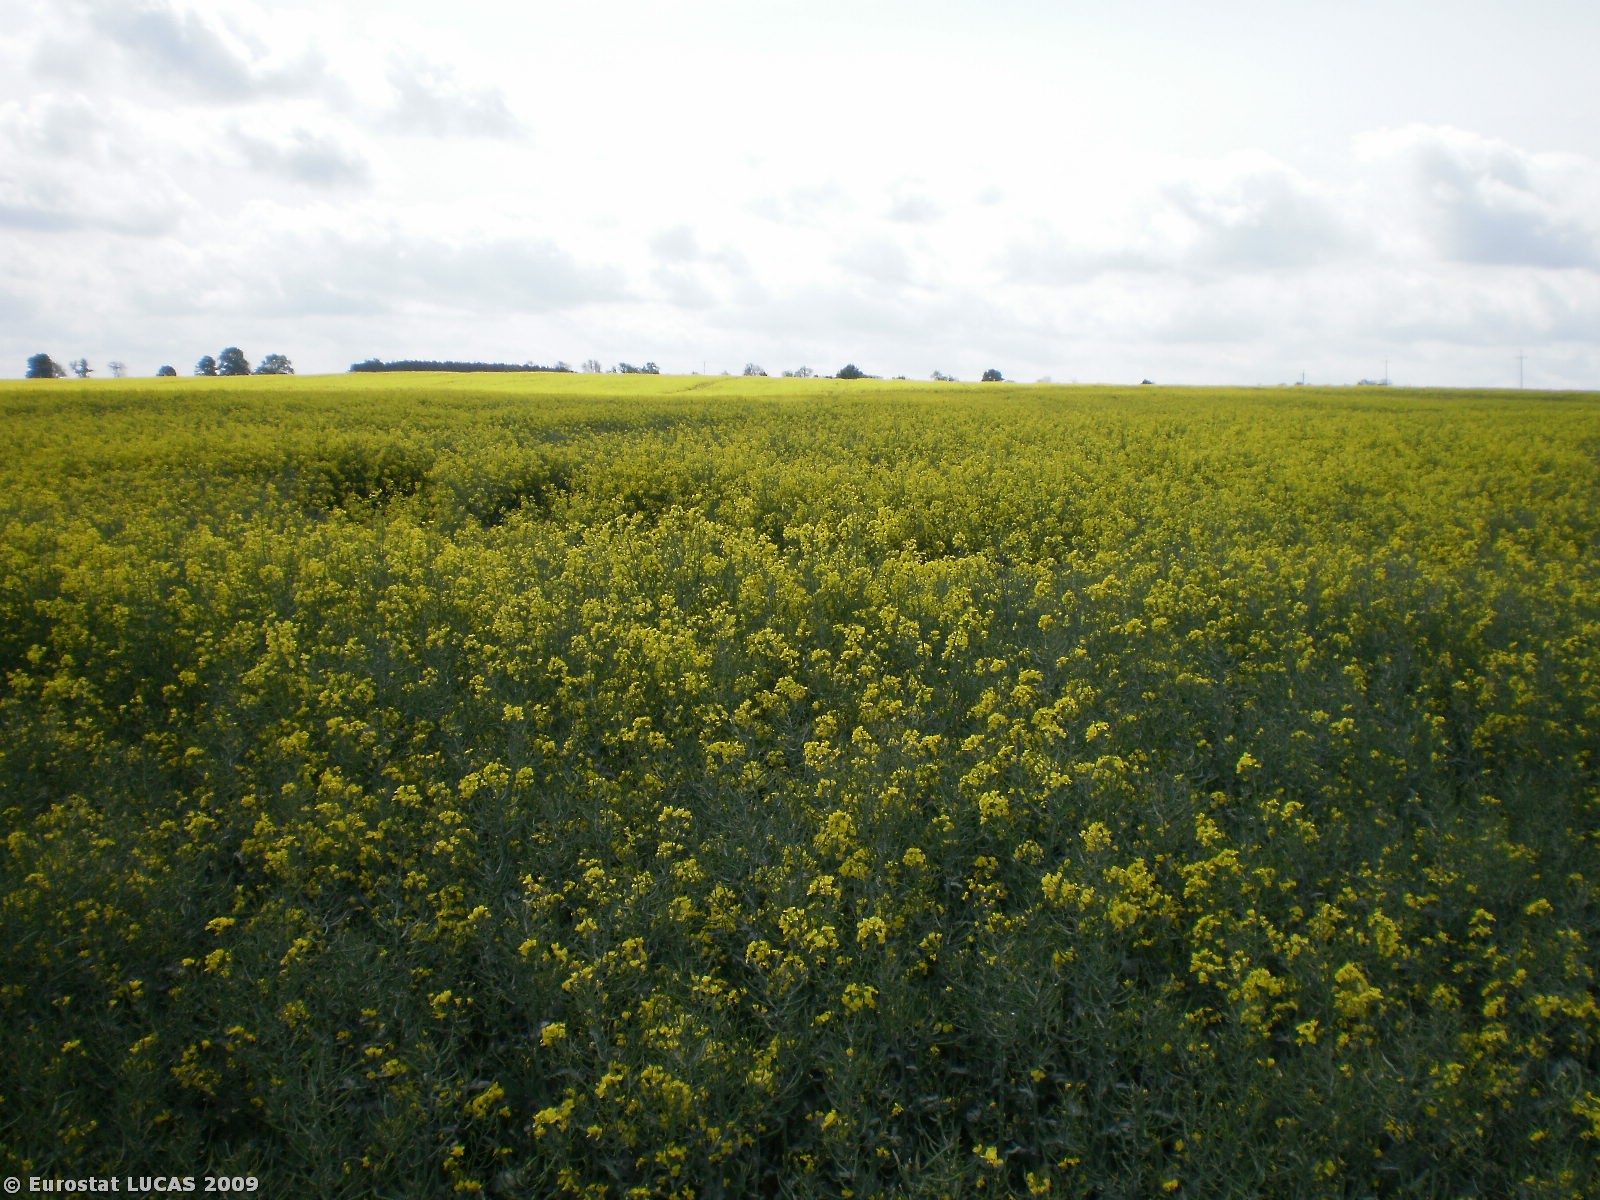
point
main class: Cropland
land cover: Rape and turnip rape
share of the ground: > 75 %
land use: Agriculture (excluding fallow land and kitchen gardens)
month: May
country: PL
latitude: 53.5663
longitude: 17.7894
